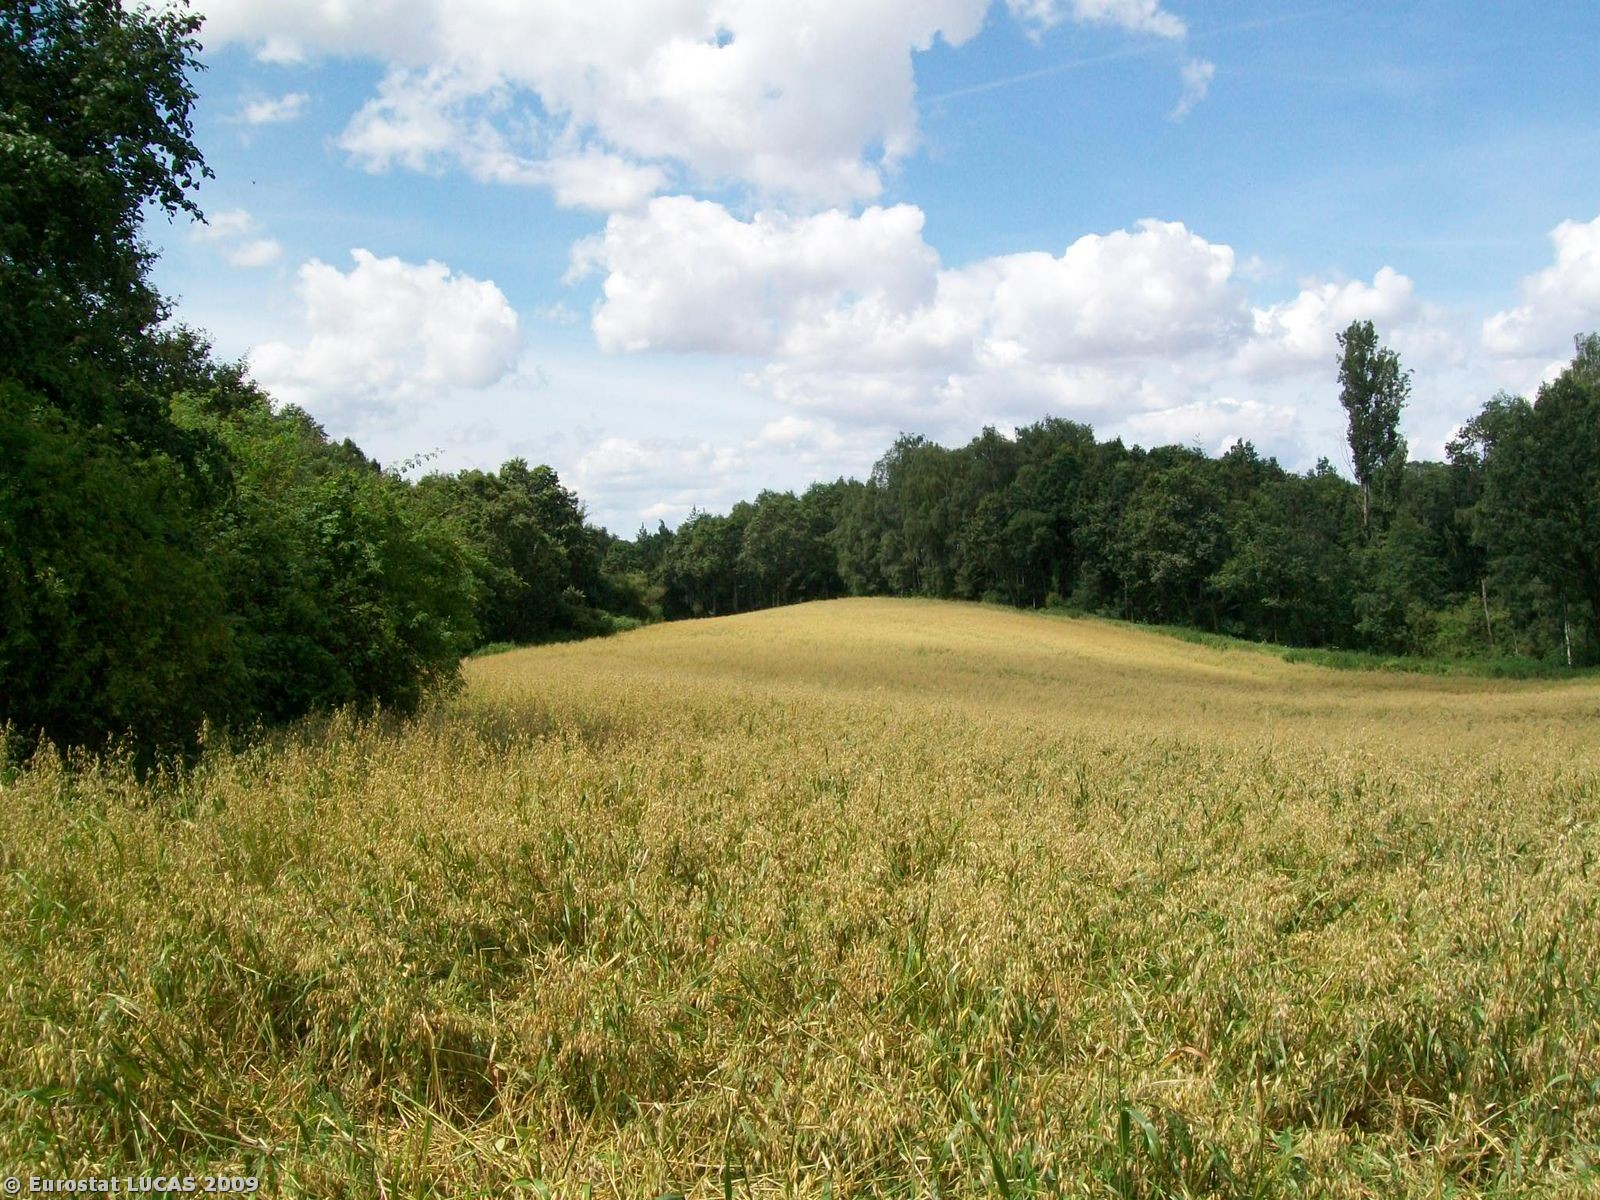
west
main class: Cropland
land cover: Oats
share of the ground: > 75 %
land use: Agriculture (excluding fallow land and kitchen gardens)
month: July
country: PL
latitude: 51.1399
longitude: 16.0806
